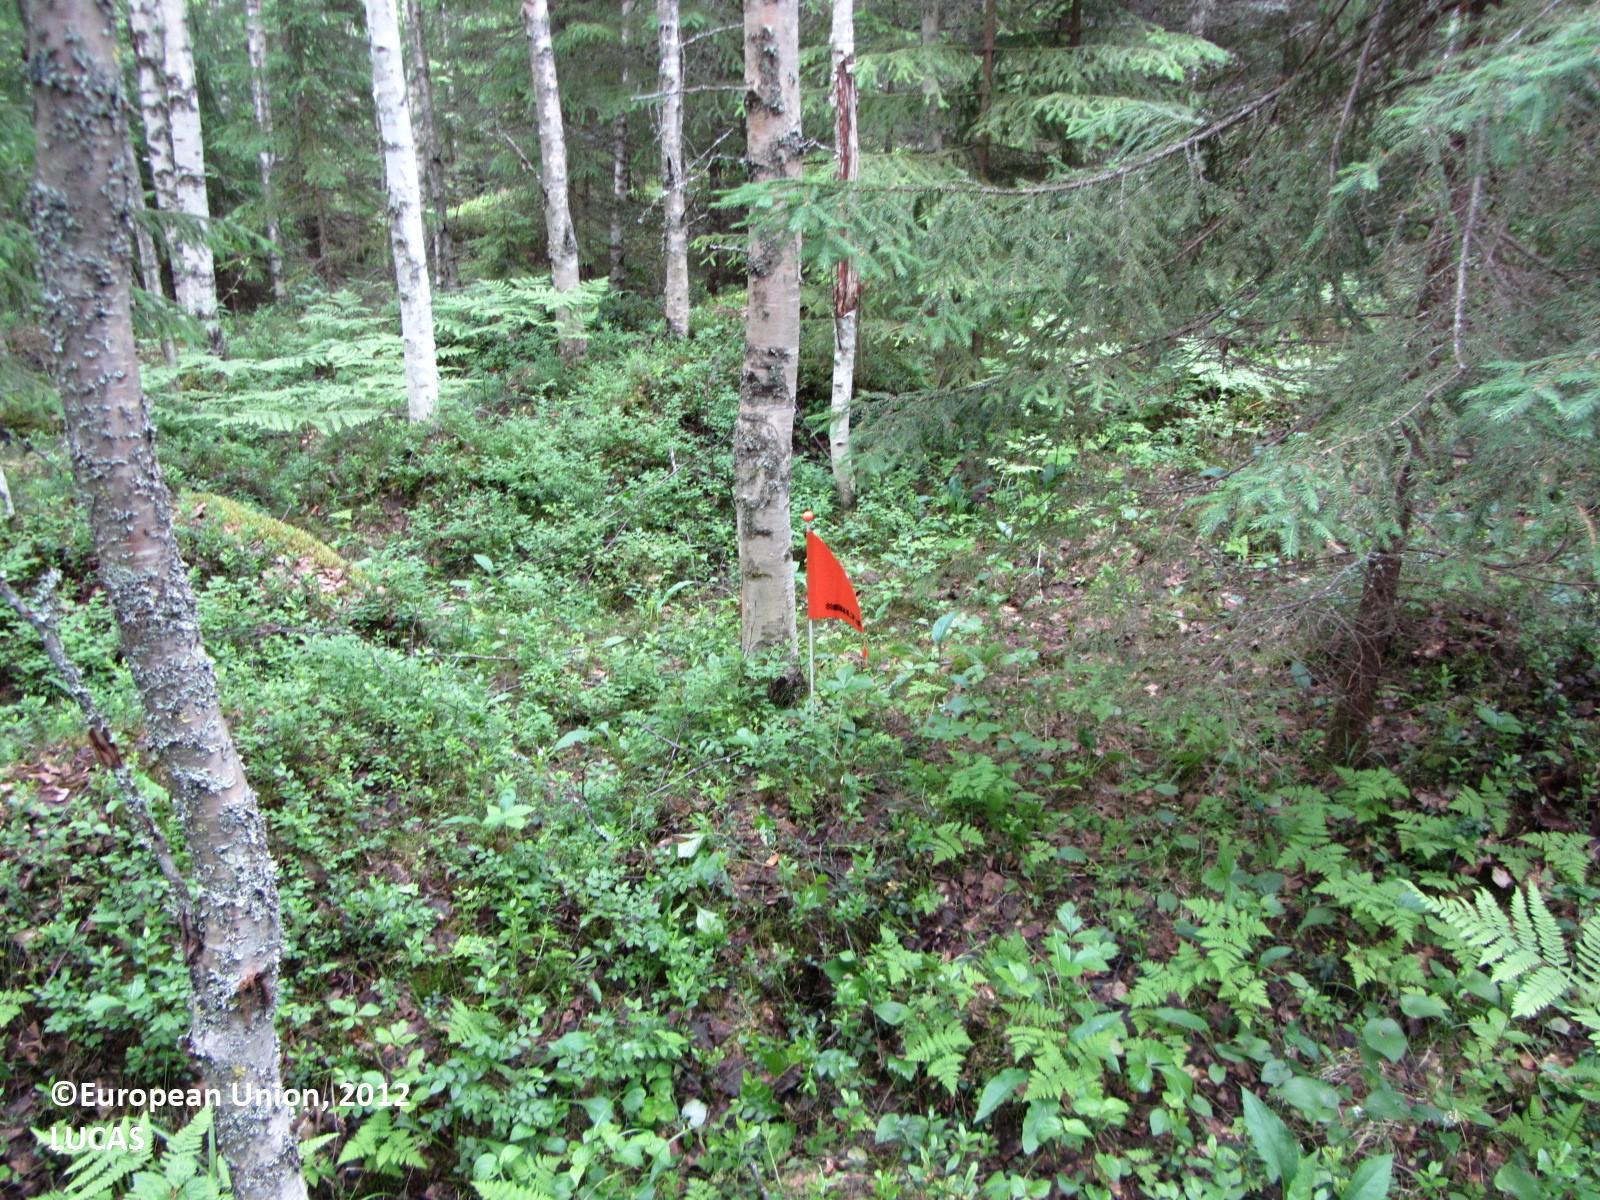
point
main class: Woodland
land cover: Spruce dominated mixed woodland
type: boreal forest
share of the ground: > 75 %
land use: Forestry
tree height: > 5 m
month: June
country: FI
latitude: 62.6465
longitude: 25.5424
